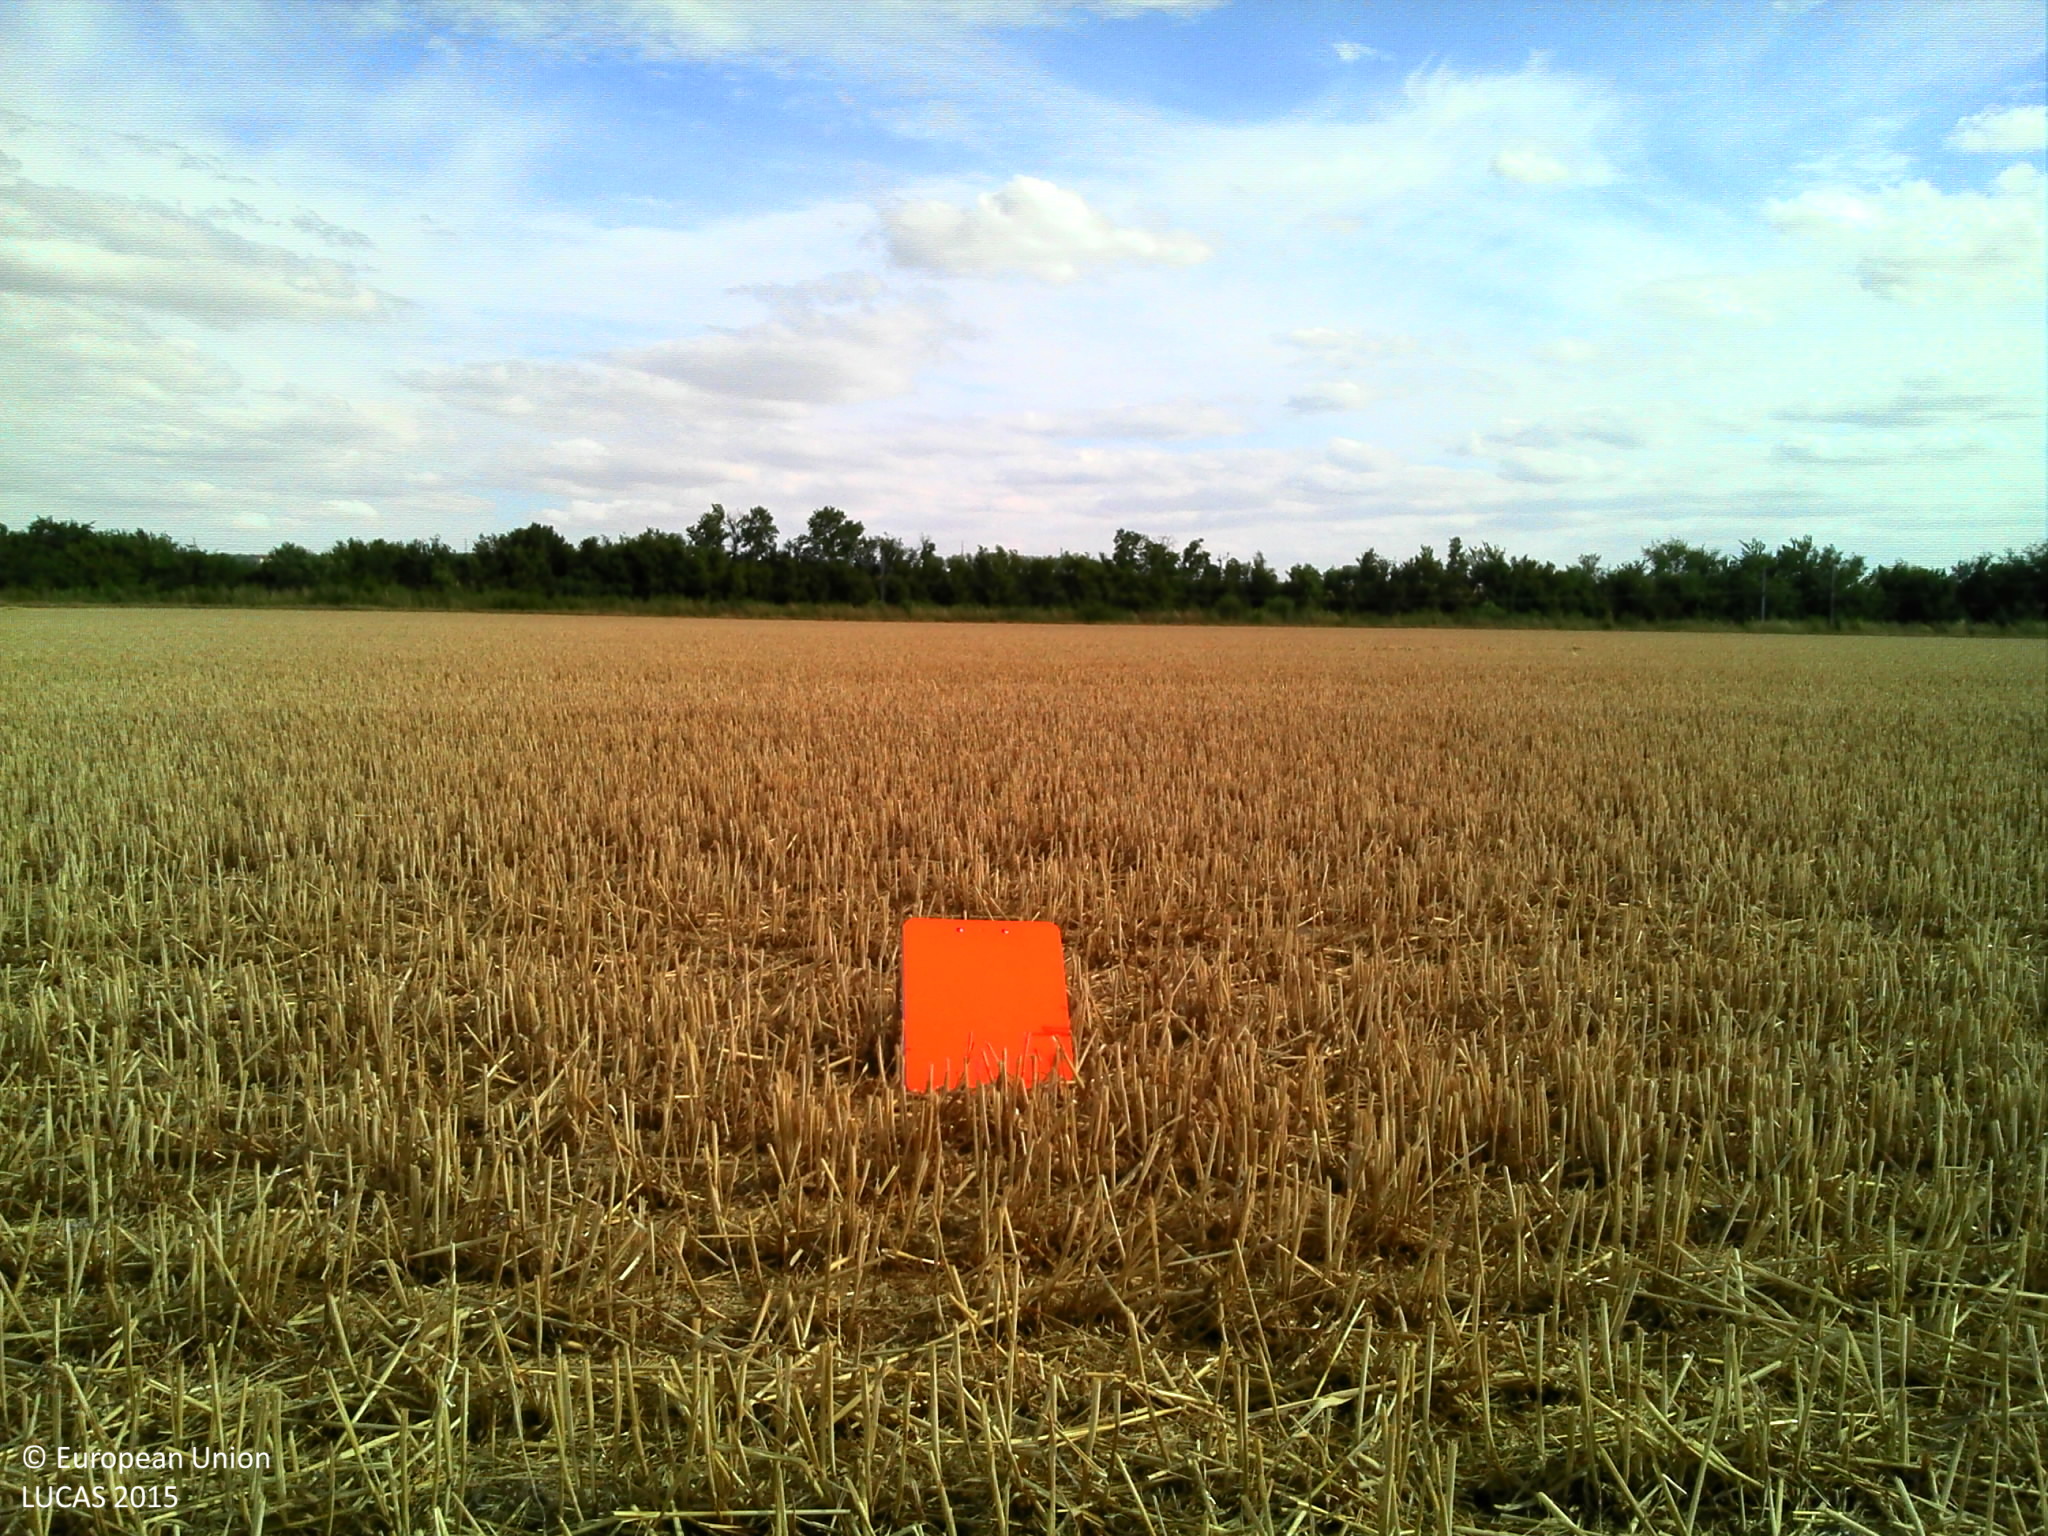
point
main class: Cropland
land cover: Durum wheat
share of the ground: > 75 %
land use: Agriculture (excluding fallow land and kitchen gardens)
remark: Harvested field
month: July
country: FR
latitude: 49.2920
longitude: 4.0966
